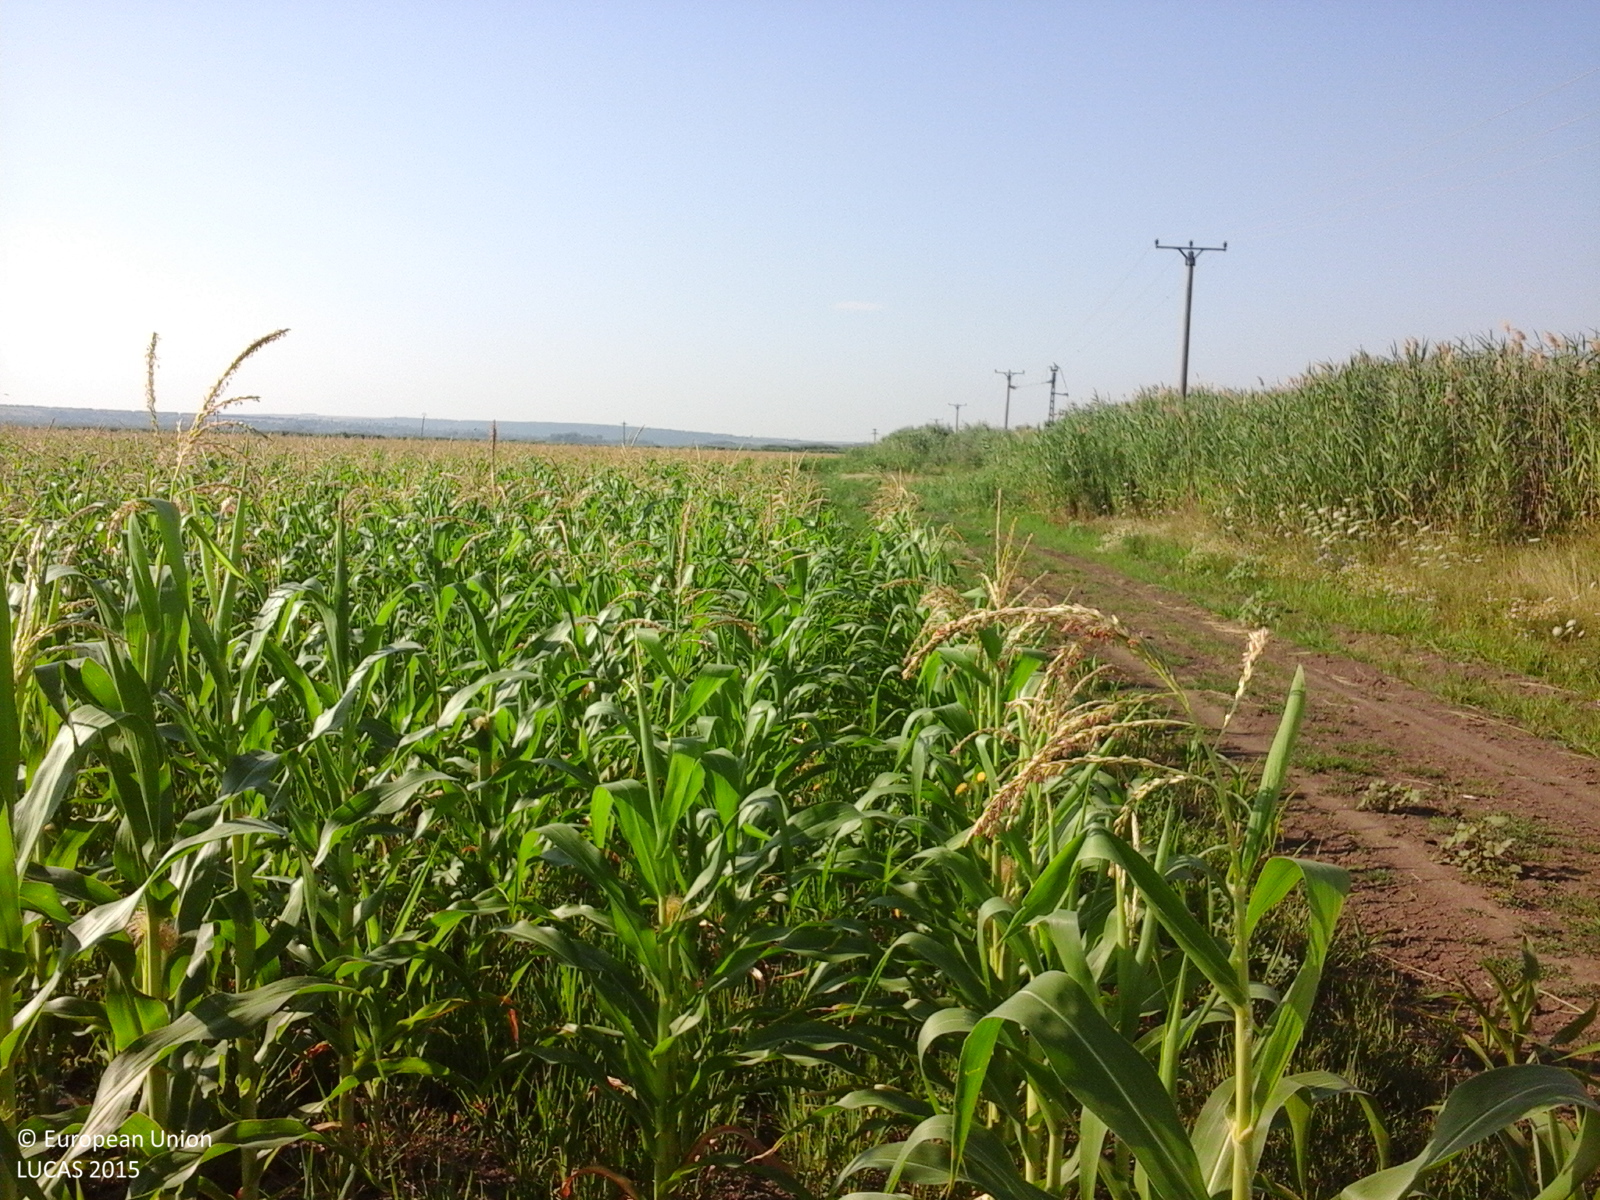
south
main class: Cropland
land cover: Maize
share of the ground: > 75 %
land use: Agriculture (excluding fallow land and kitchen gardens)
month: July
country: RO
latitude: 46.3269
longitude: 28.1725
